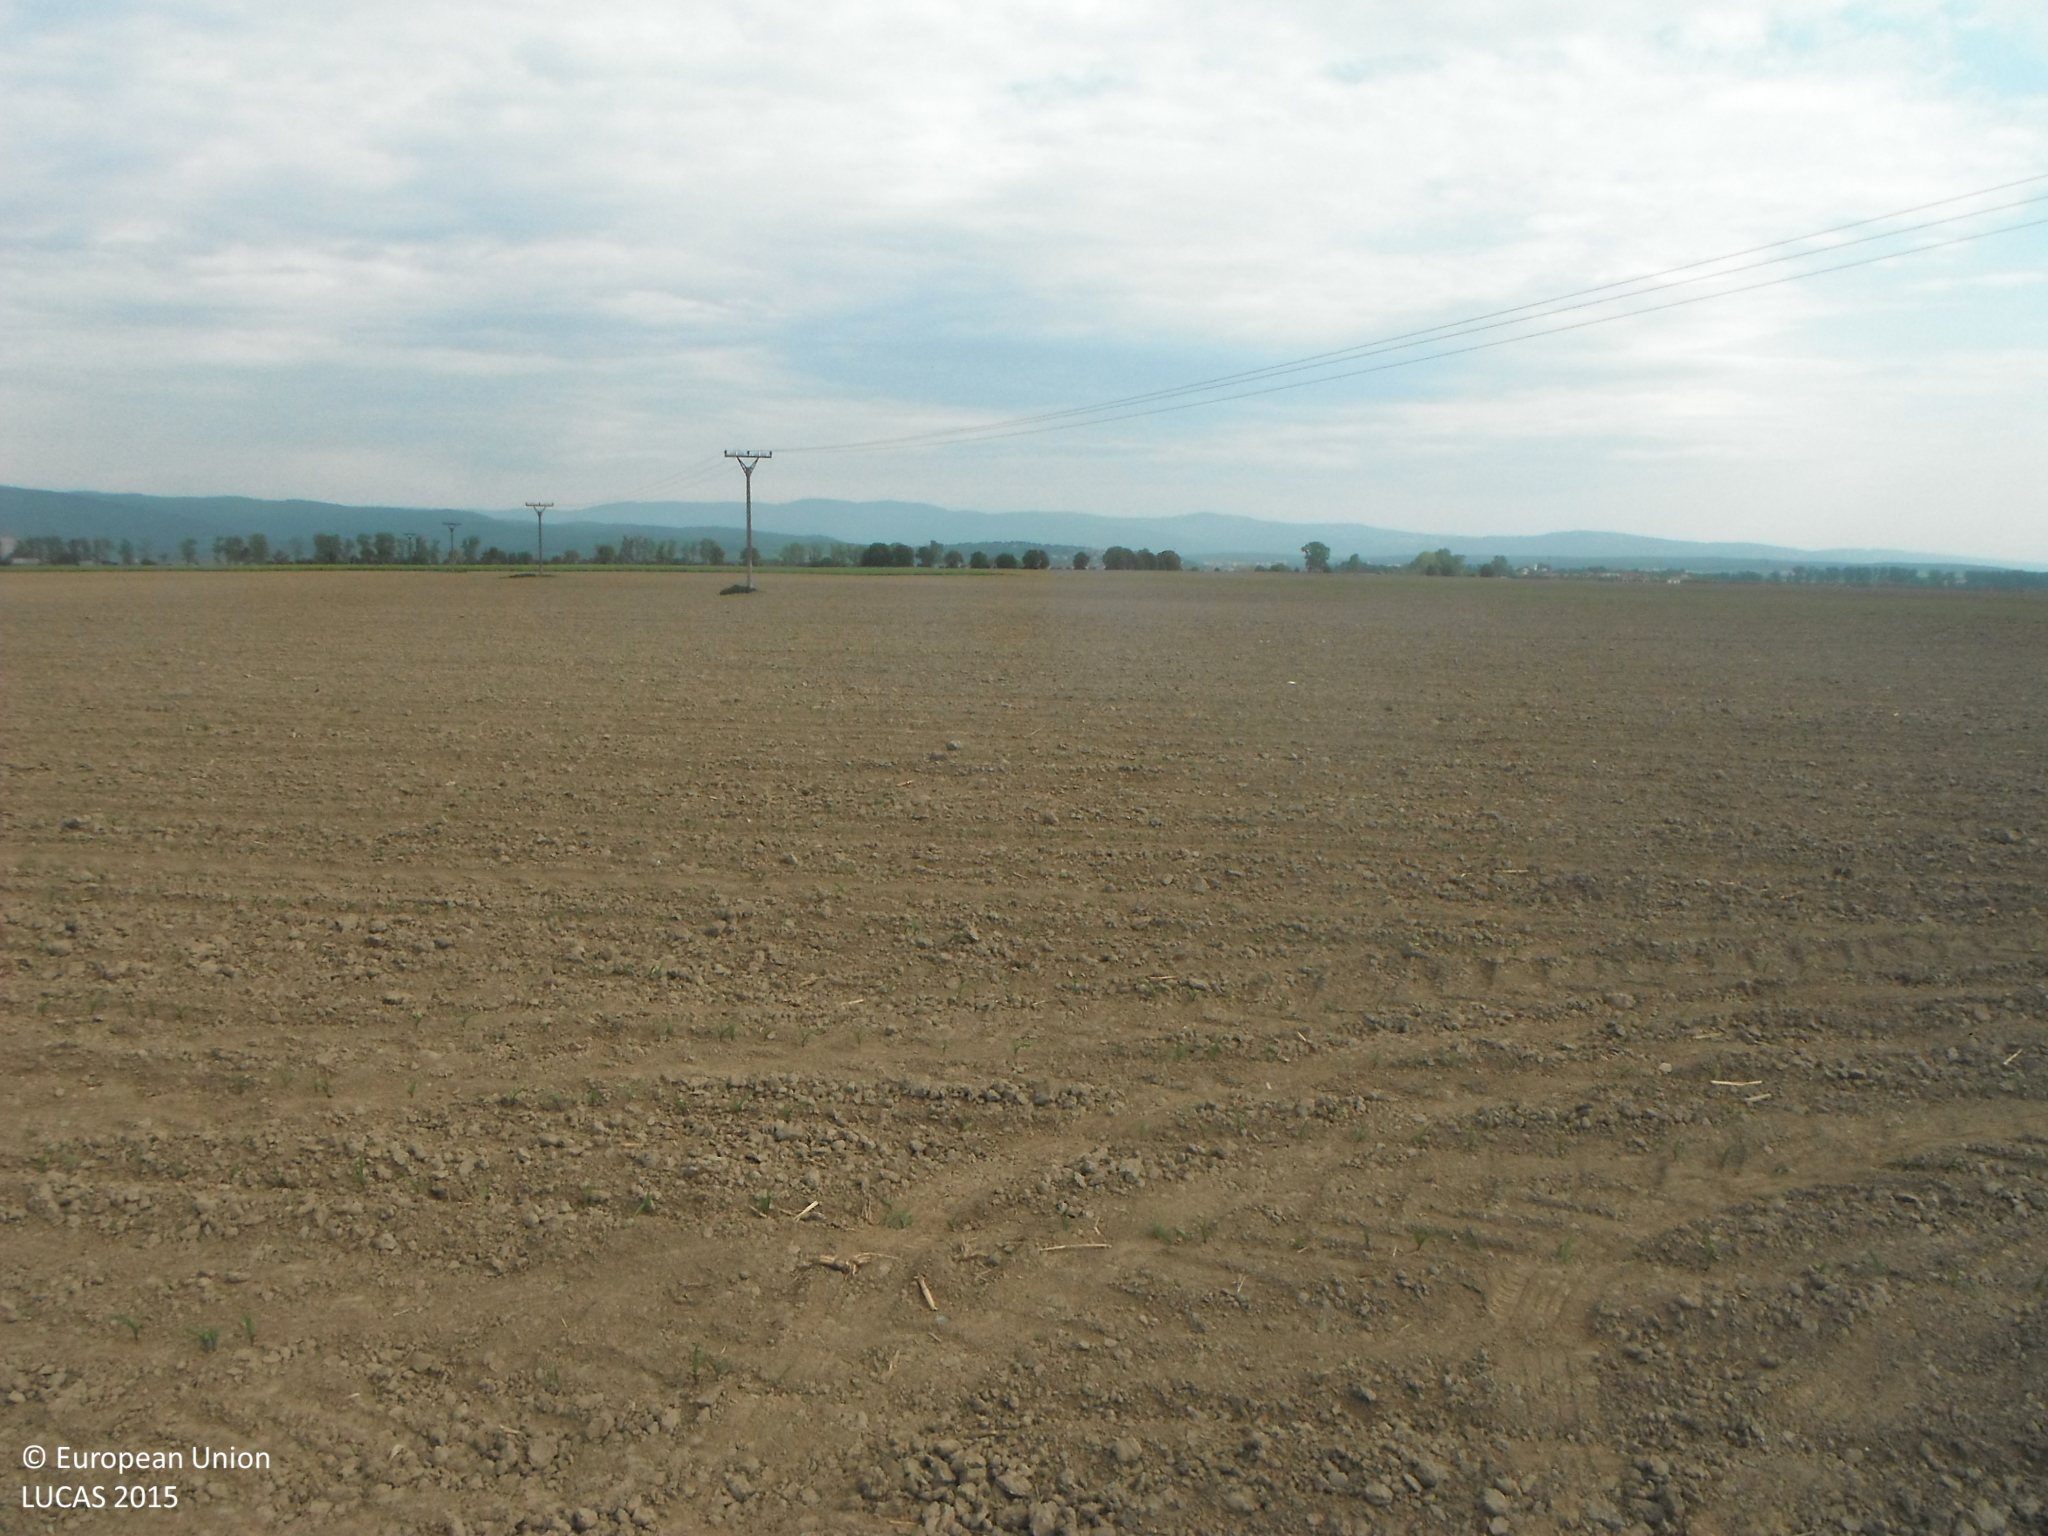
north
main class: Cropland
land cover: Maize
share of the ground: < 10 %
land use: Agriculture (excluding fallow land and kitchen gardens)
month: May
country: SK
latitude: 48.5634
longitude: 20.9759
